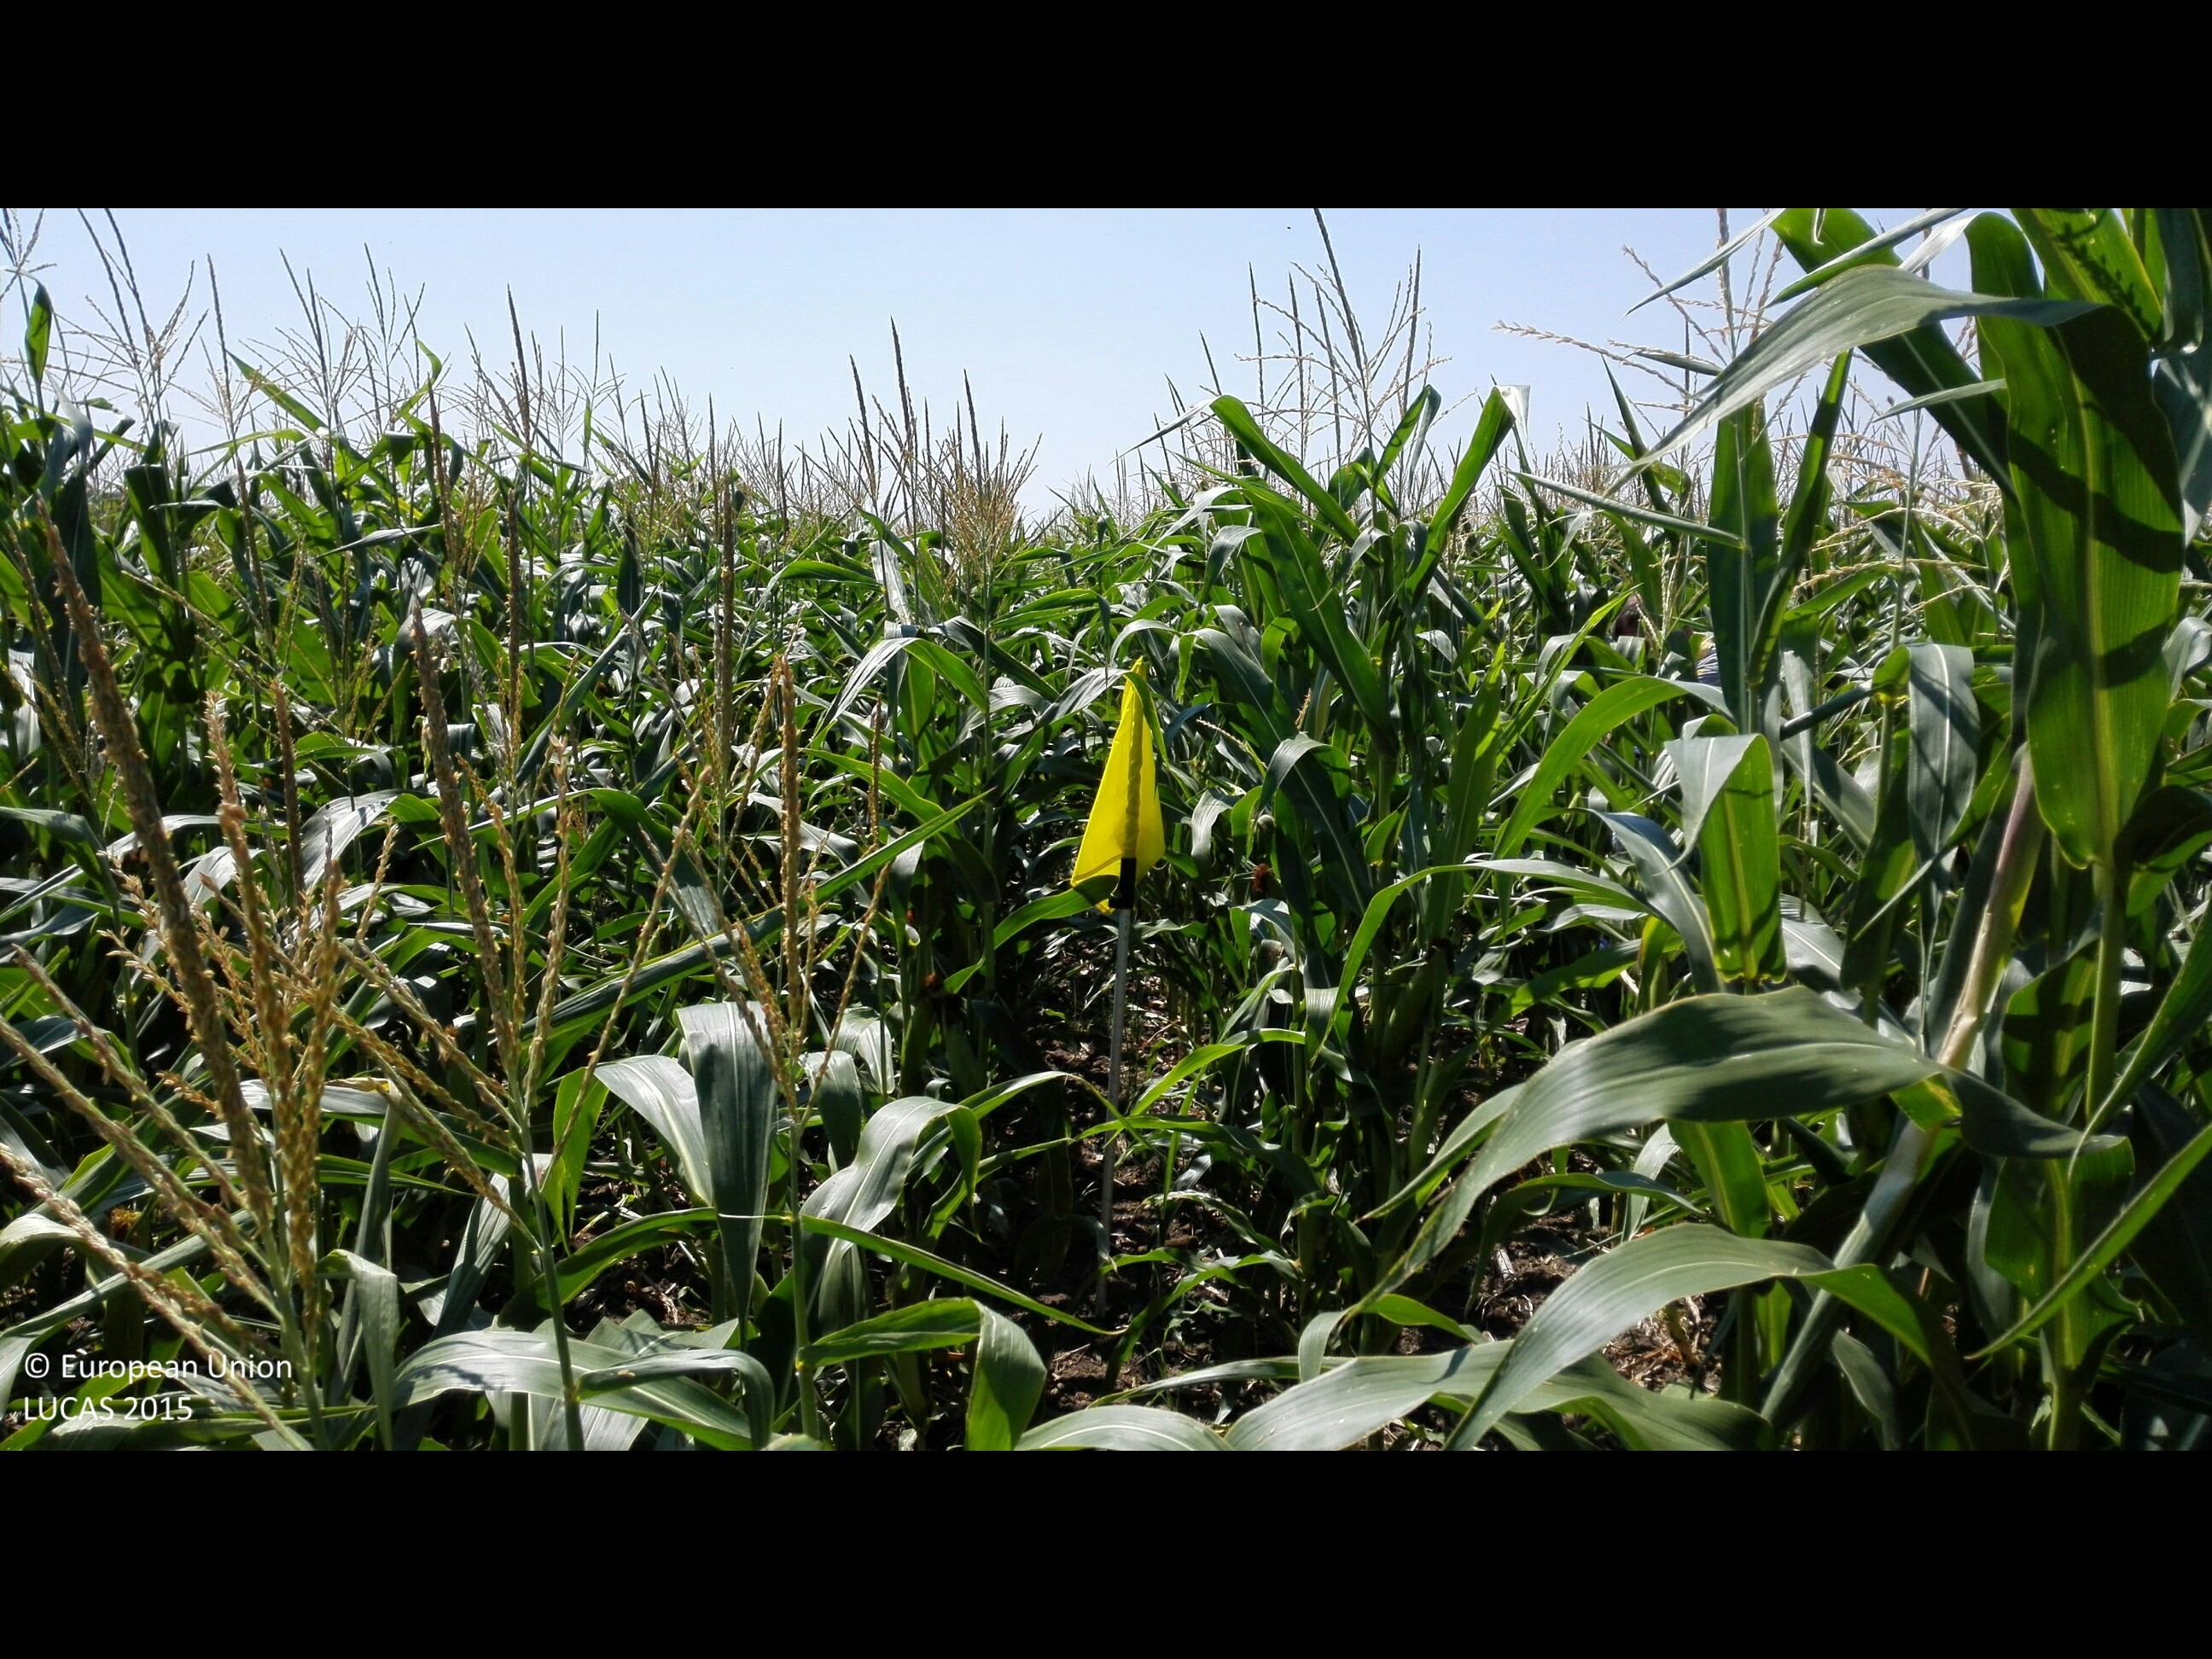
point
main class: Cropland
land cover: Maize
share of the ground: > 75 %
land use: Agriculture (excluding fallow land and kitchen gardens)
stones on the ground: < 10 %
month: July
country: HU
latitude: 47.2249
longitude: 21.2775
